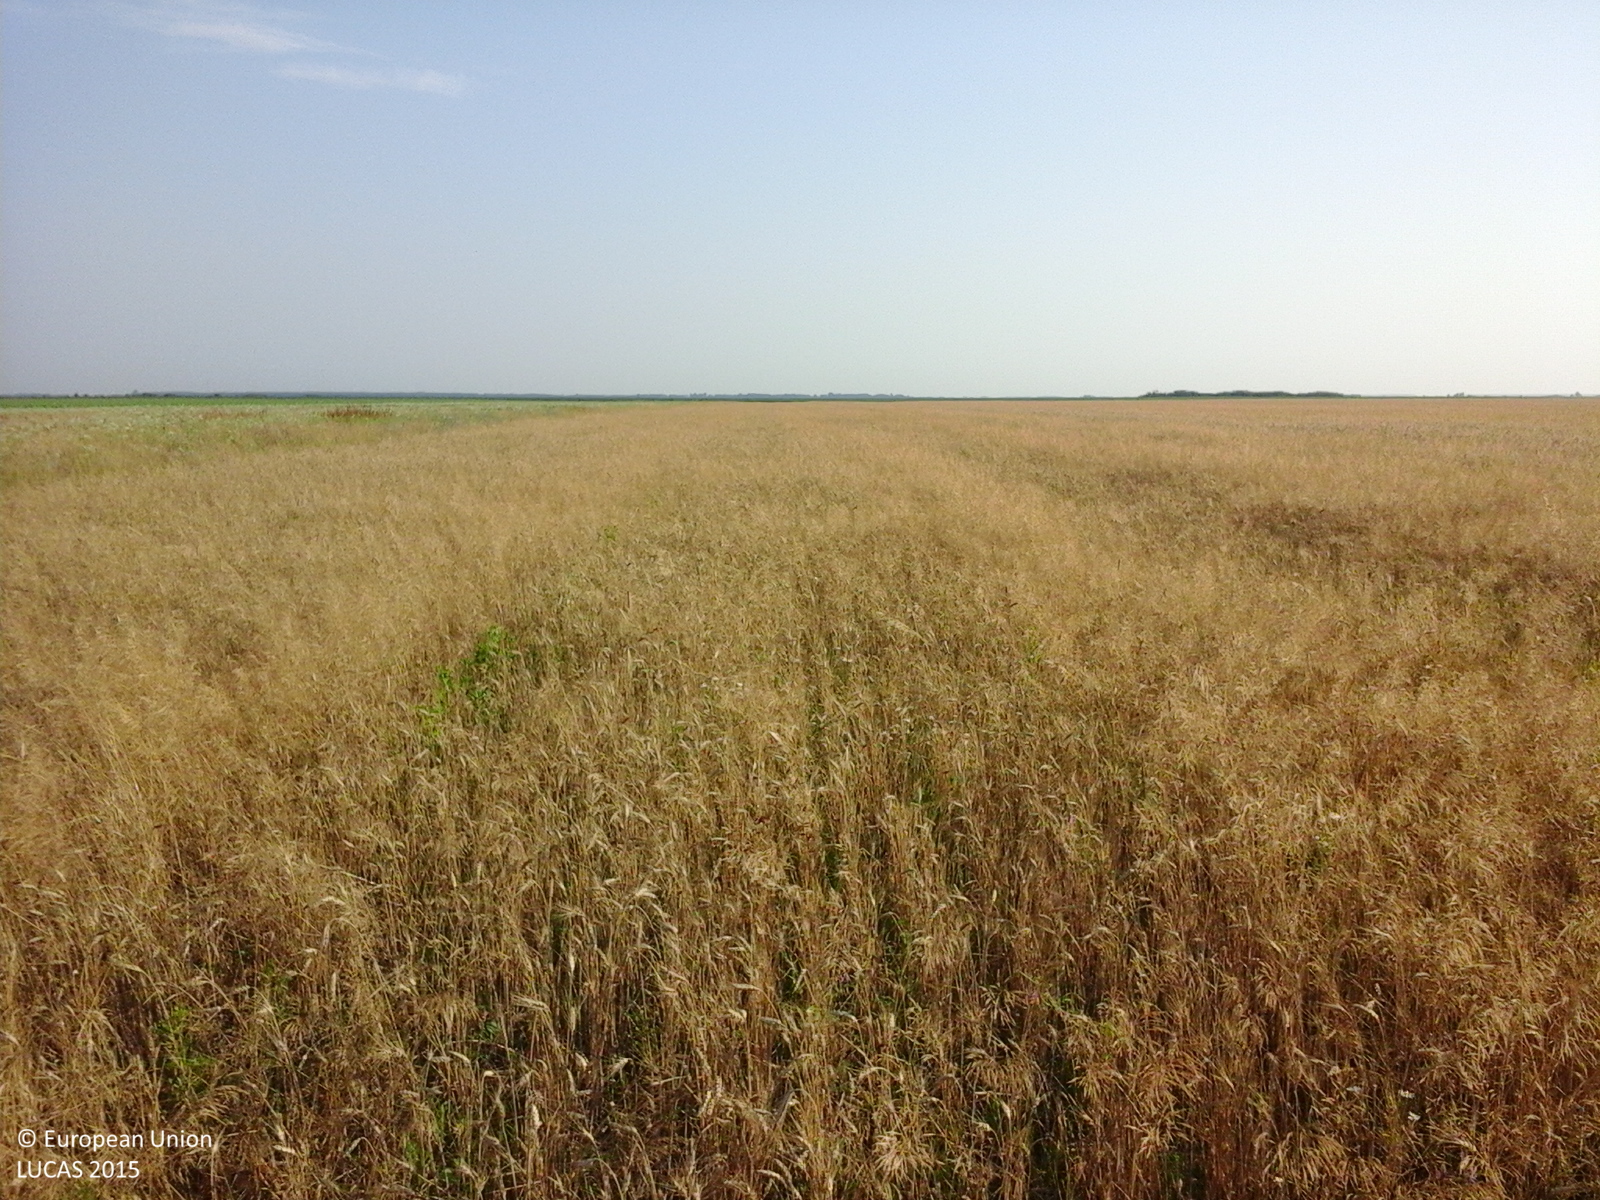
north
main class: Cropland
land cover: Common wheat
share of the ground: > 75 %
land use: Agriculture (excluding fallow land and kitchen gardens)
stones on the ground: < 10 %
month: July
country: RO
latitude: 44.4796
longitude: 25.0046
